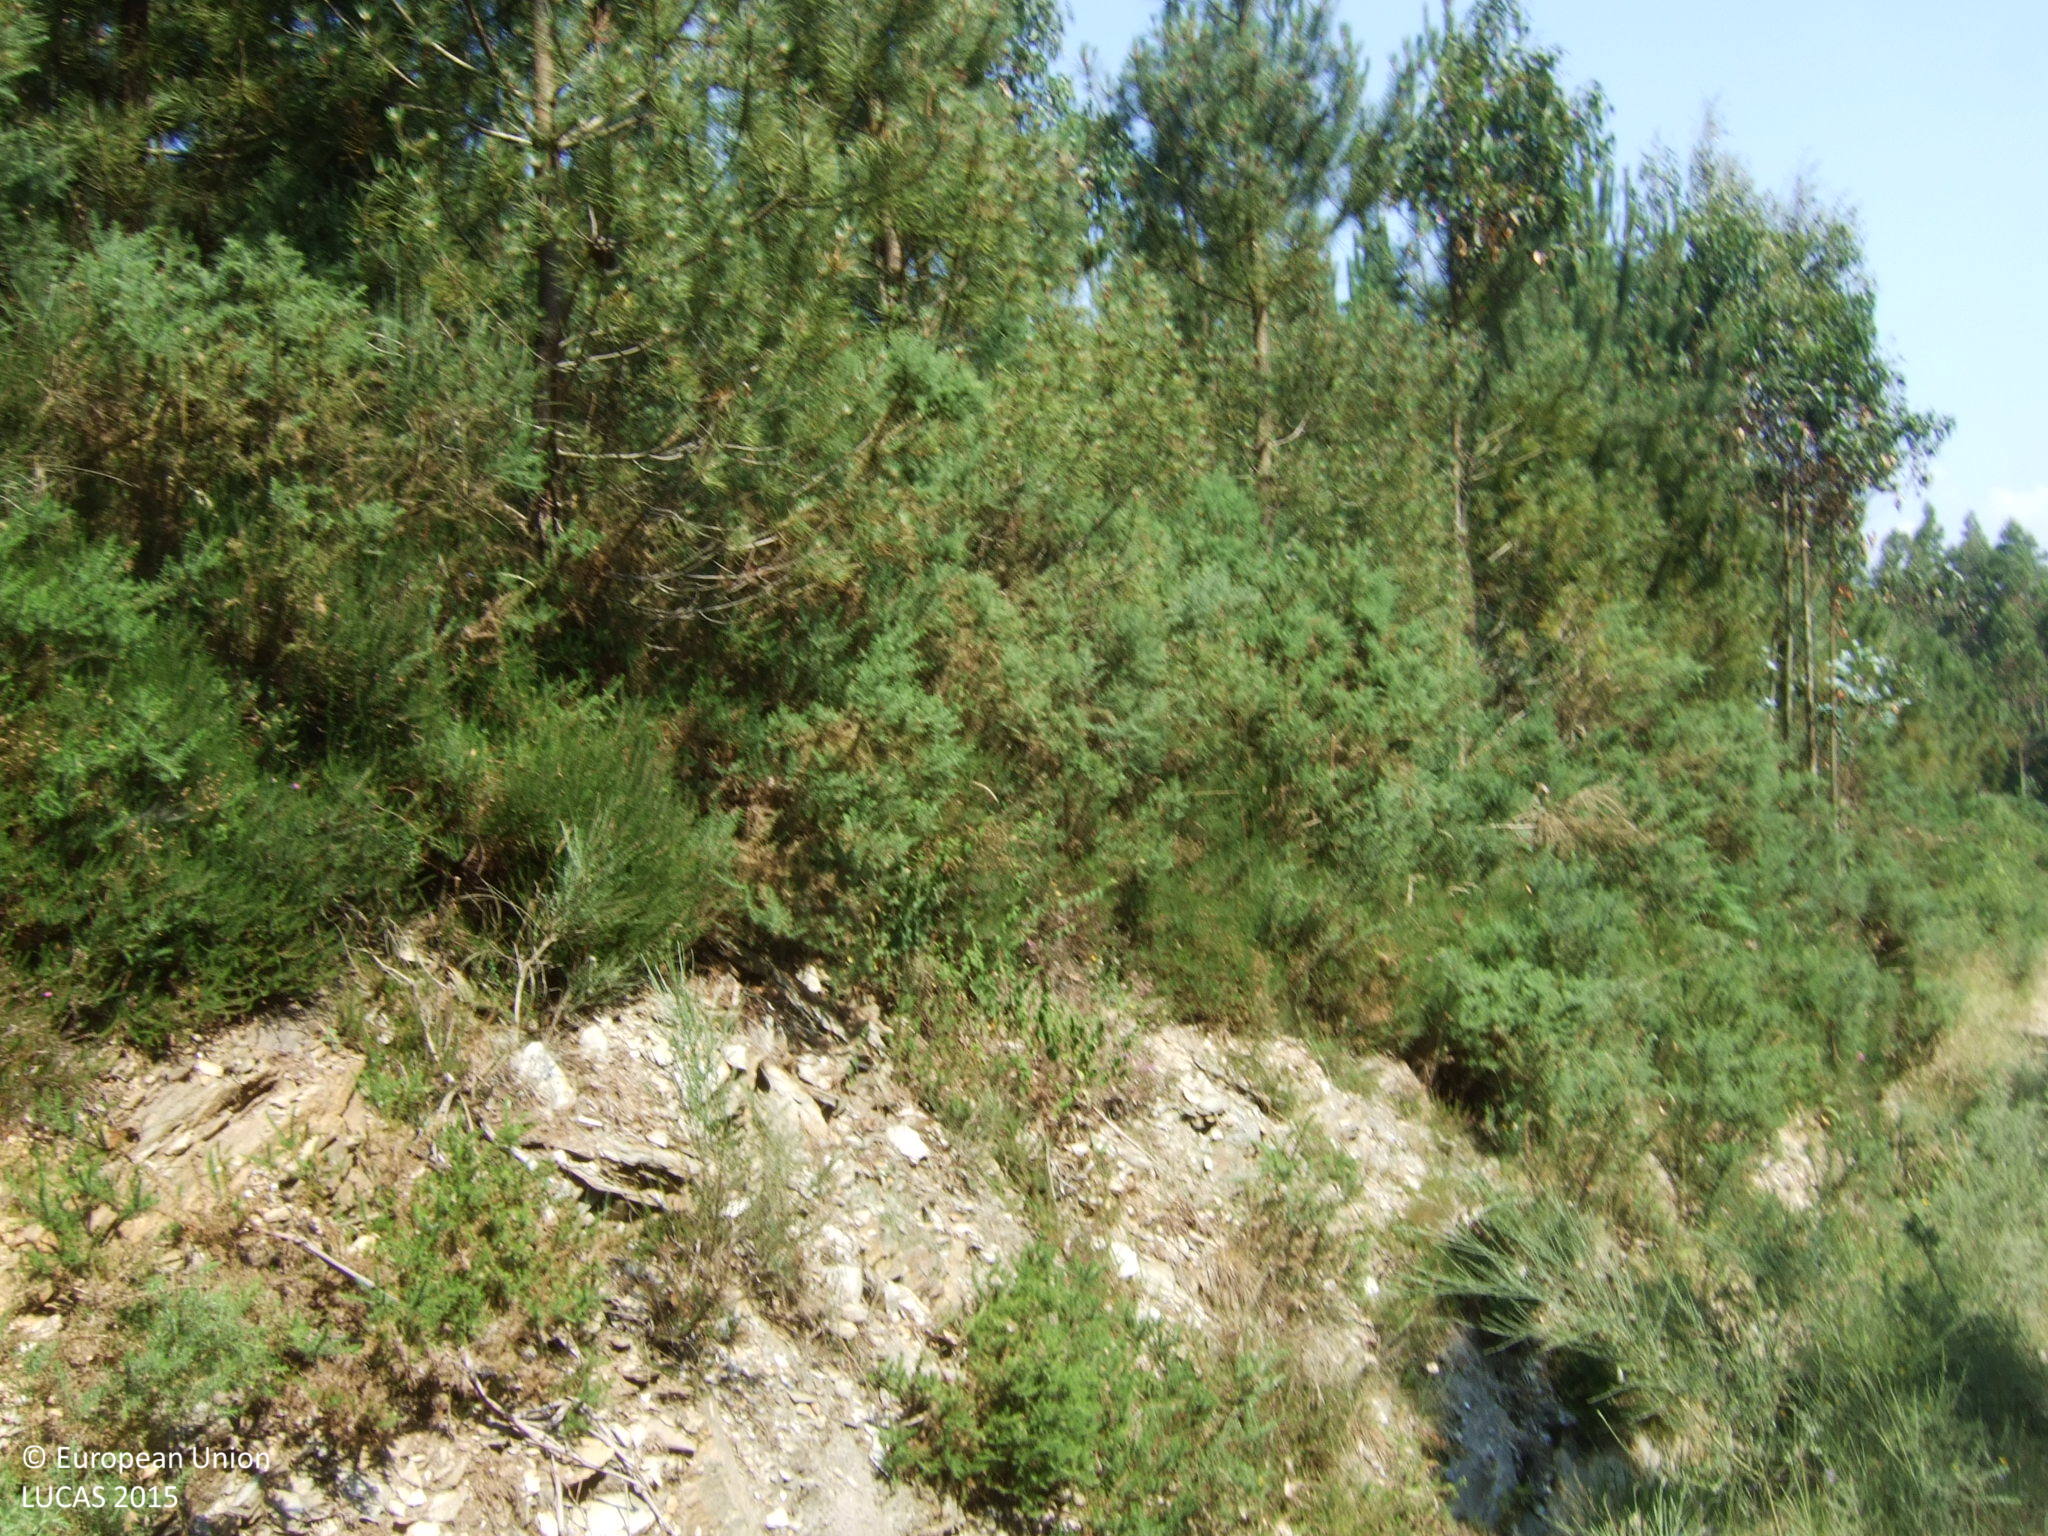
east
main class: Woodland
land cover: Pine dominated mixed woodland
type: exotic forest
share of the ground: 25 - 50 %
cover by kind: shrubs 50 %, coniferous forest trees 25 %, broadleaved forest trees 25 %
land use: Forestry
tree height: < 5 m
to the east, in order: Pine dominated mixed woodland; Tracks
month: June
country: ES
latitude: 43.4554
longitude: -7.1888
